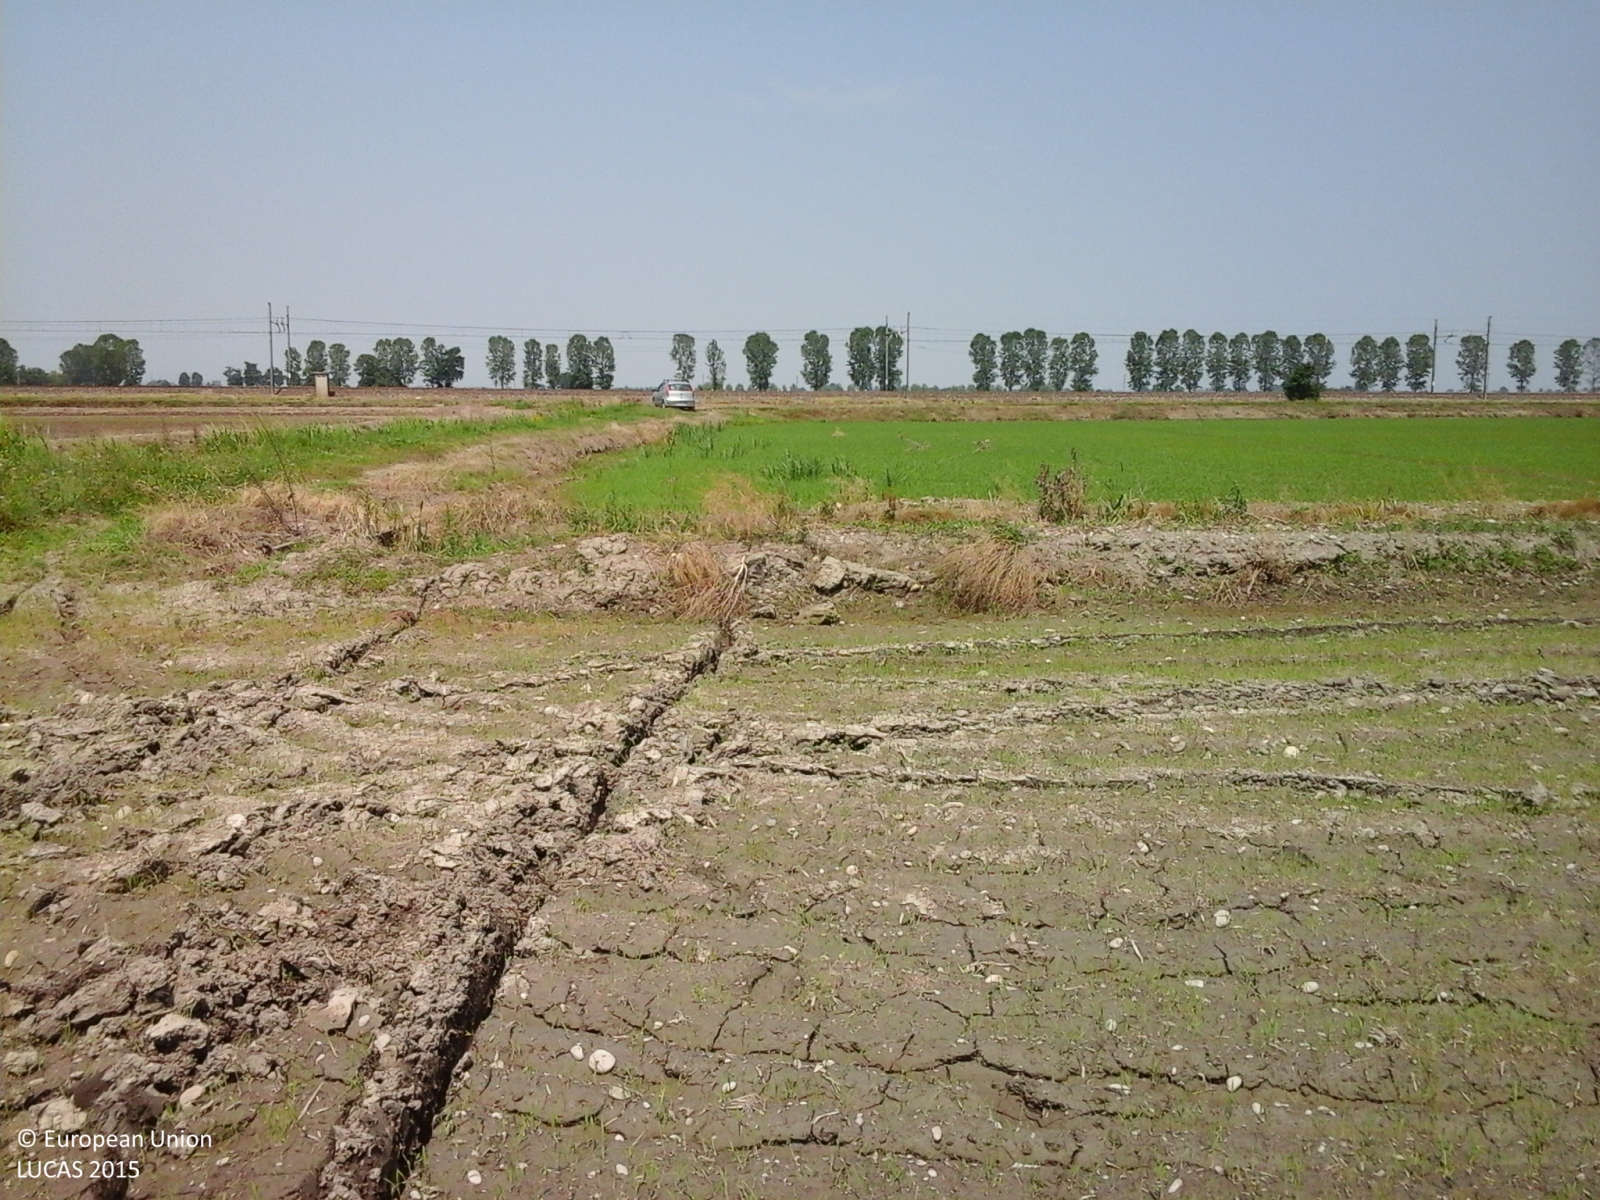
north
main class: Cropland
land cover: Rice
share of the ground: < 10 %
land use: Agriculture (excluding fallow land and kitchen gardens)
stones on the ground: < 10 %
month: May
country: IT
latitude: 45.3462
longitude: 8.2799
